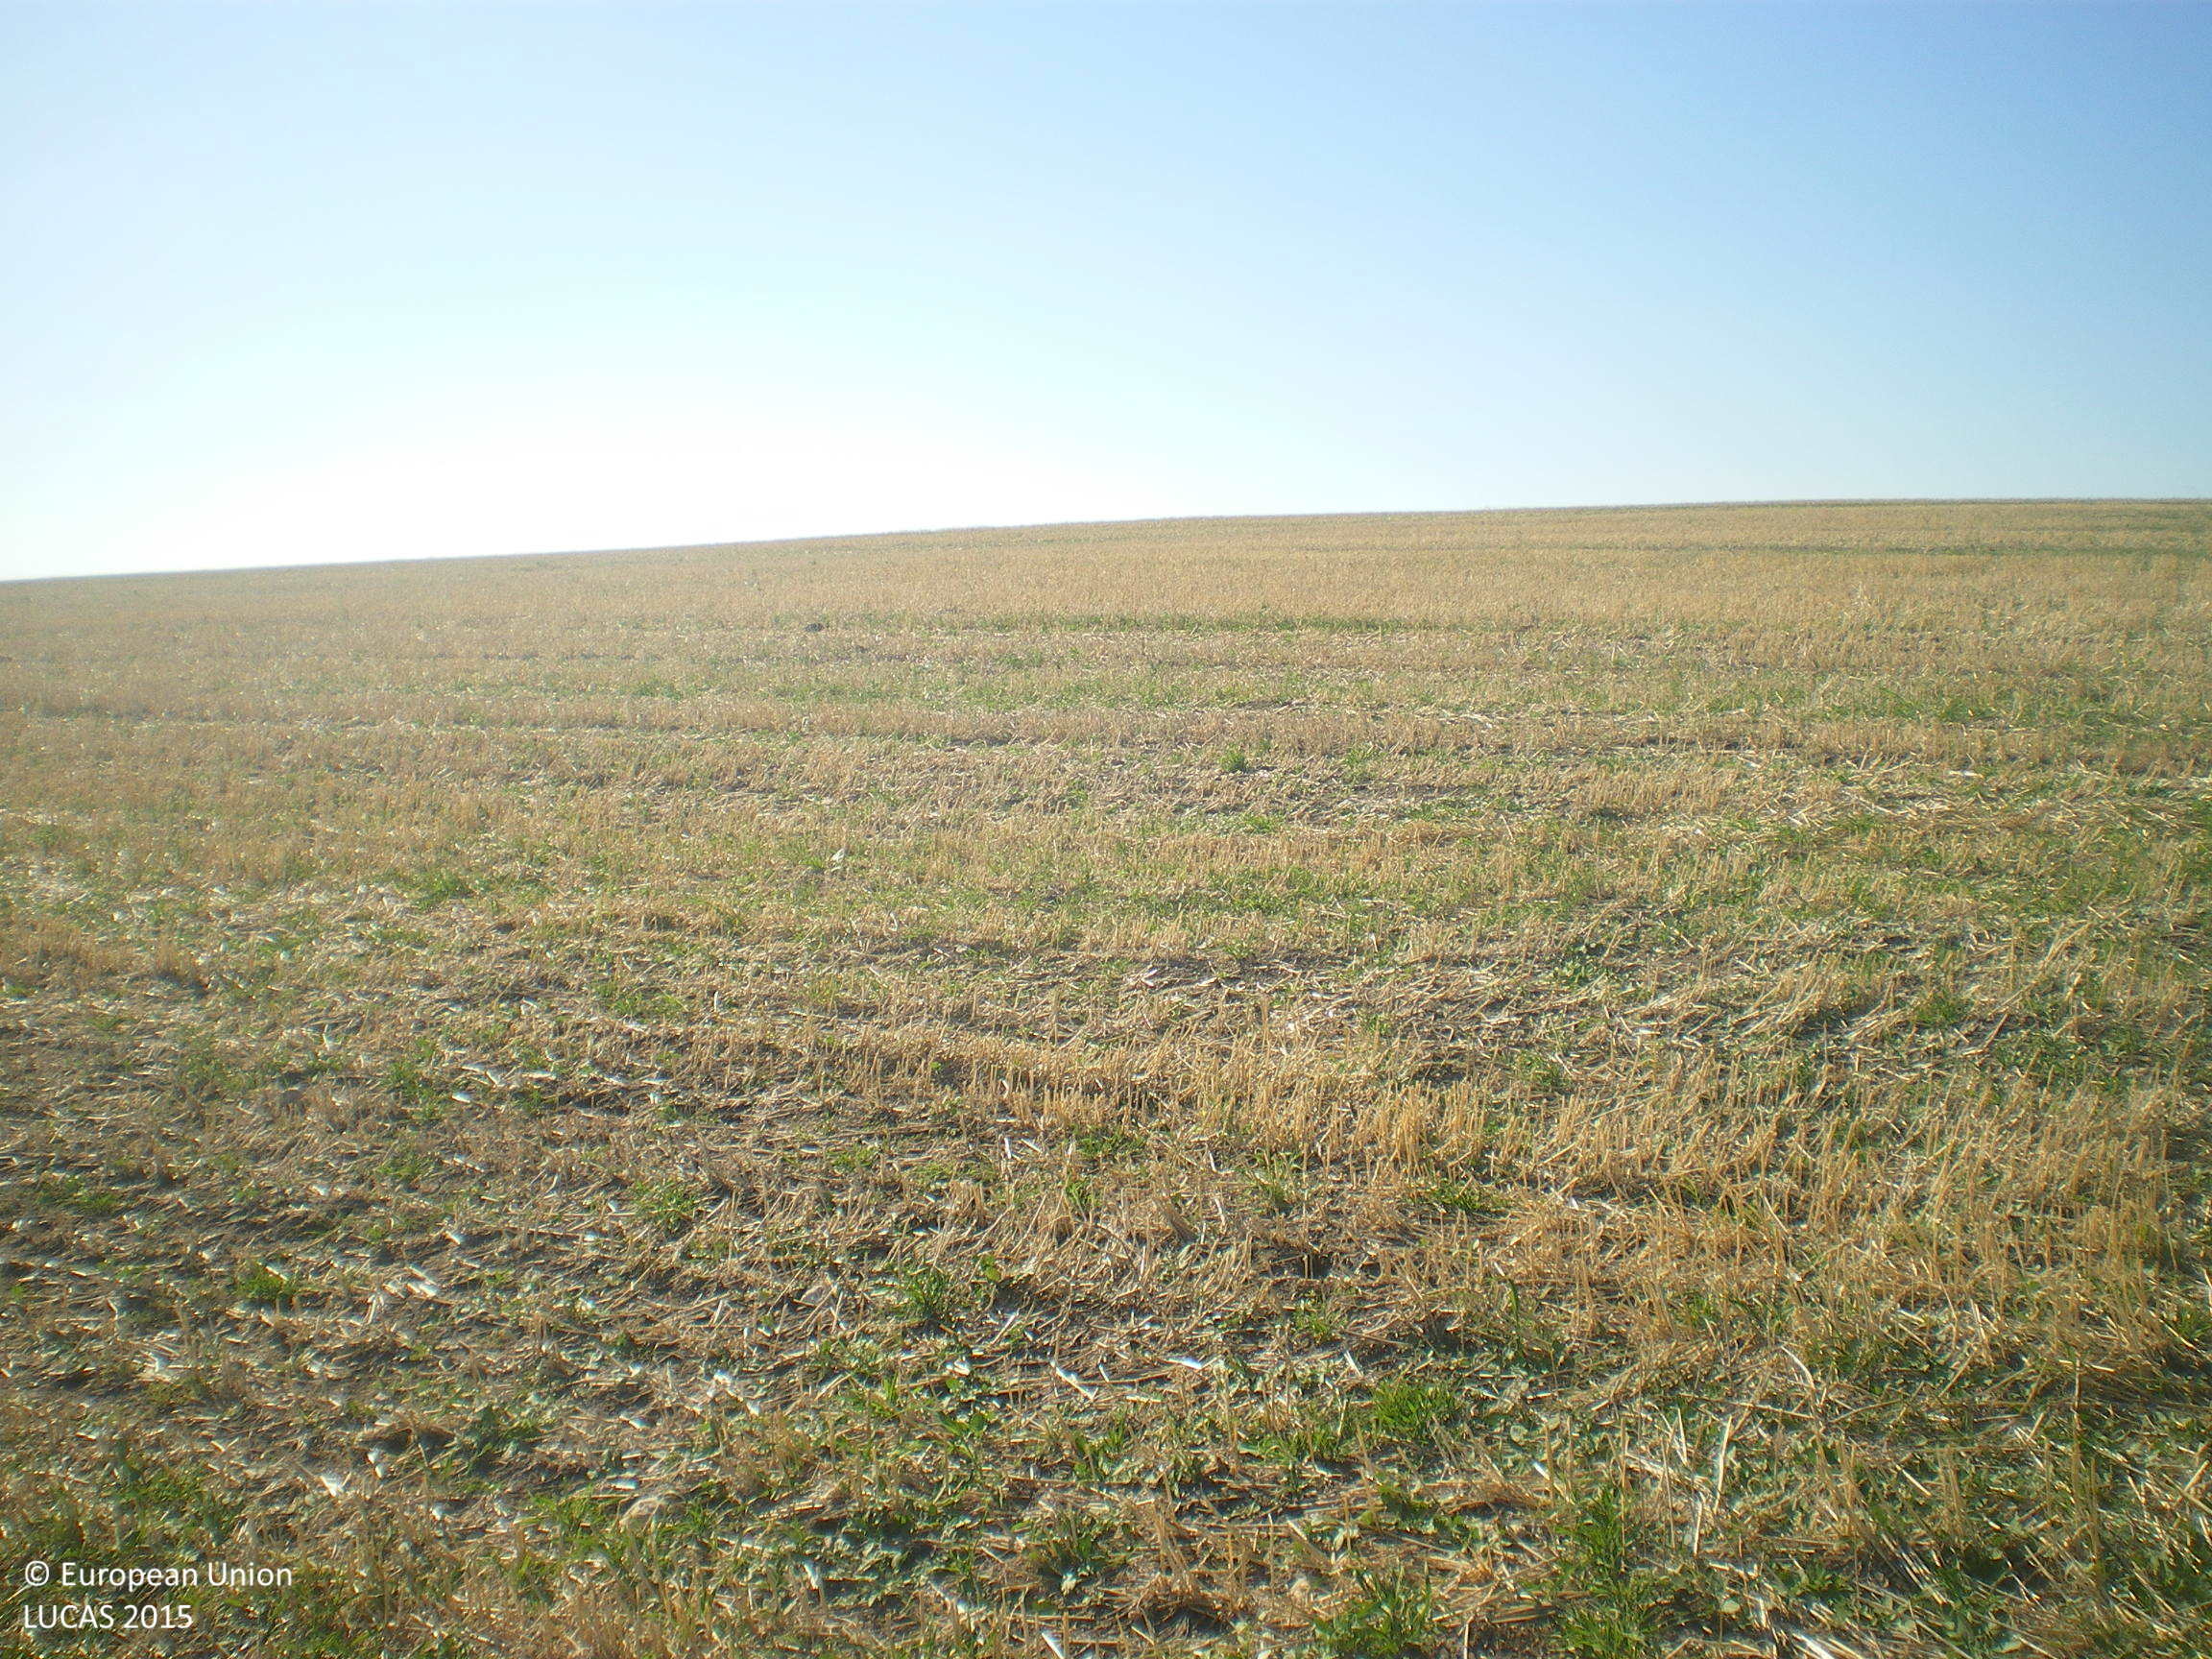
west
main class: Cropland
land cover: Common wheat
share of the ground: 10 - 25 %
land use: Agriculture (excluding fallow land and kitchen gardens)
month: September
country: BG
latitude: 41.8342
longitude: 26.3235
